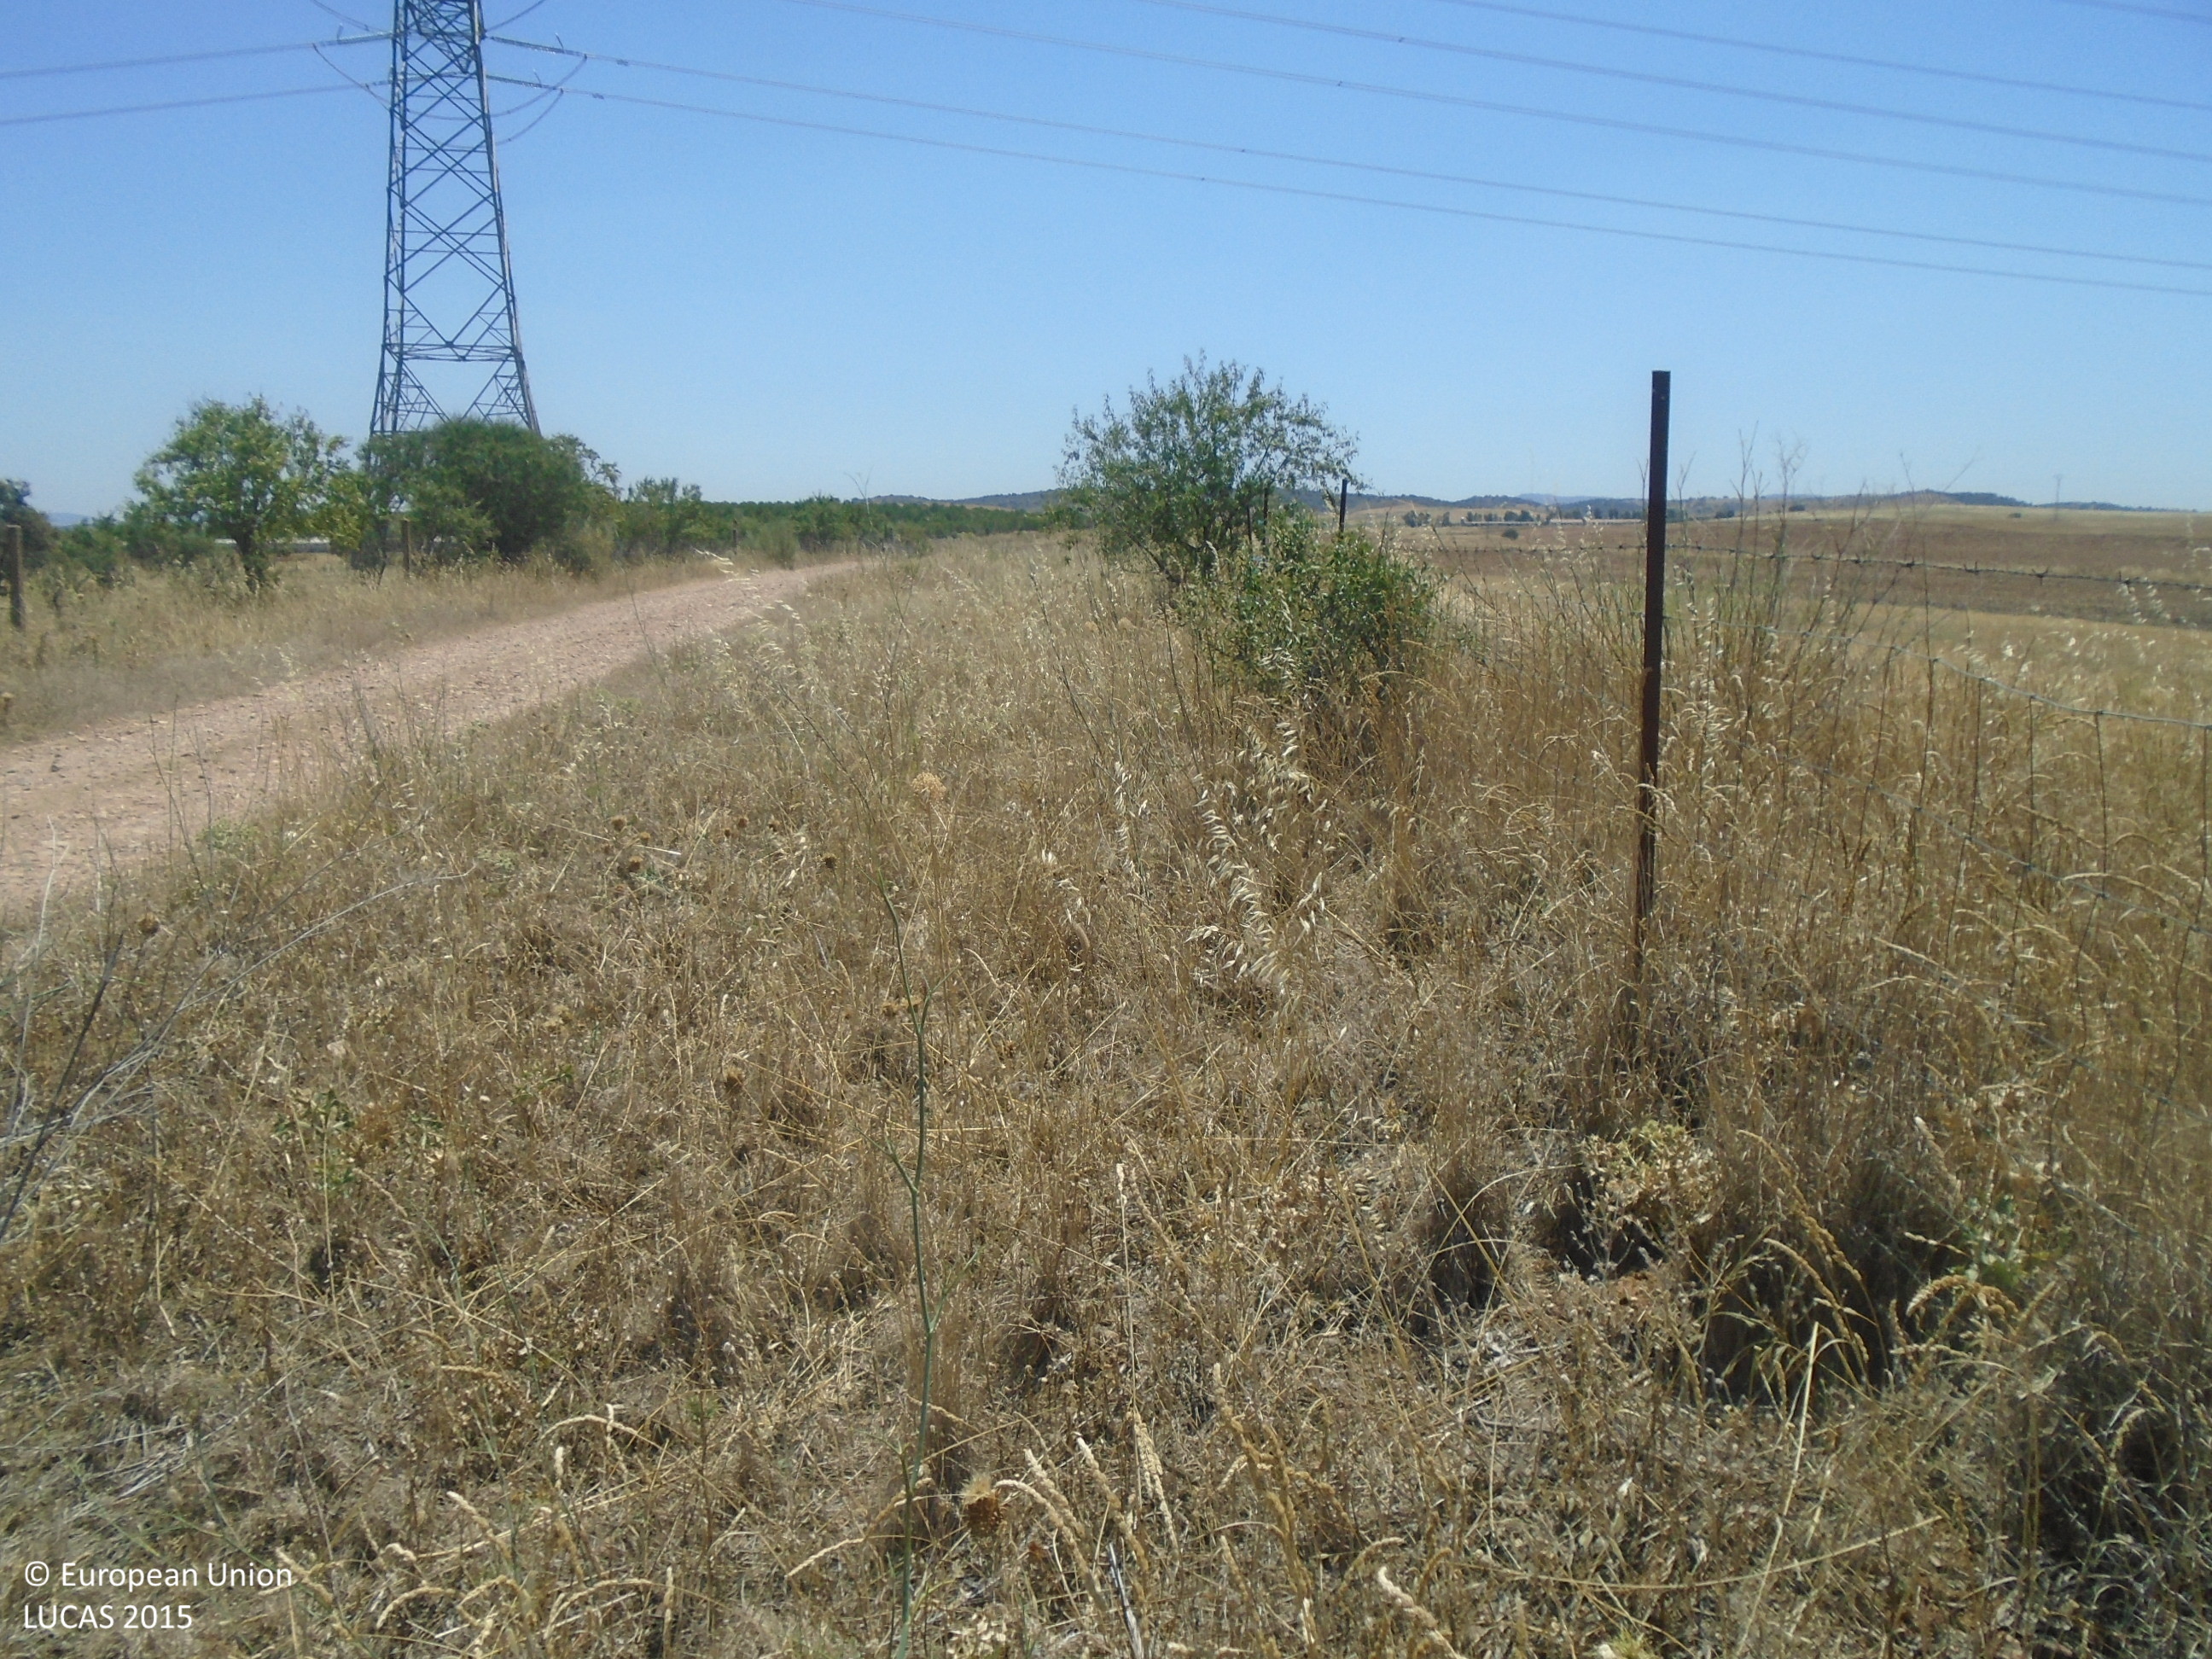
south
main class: Cropland
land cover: Barley
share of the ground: > 75 %
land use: Agriculture (excluding fallow land and kitchen gardens)
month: July
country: ES
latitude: 39.8032
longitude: -4.8915
